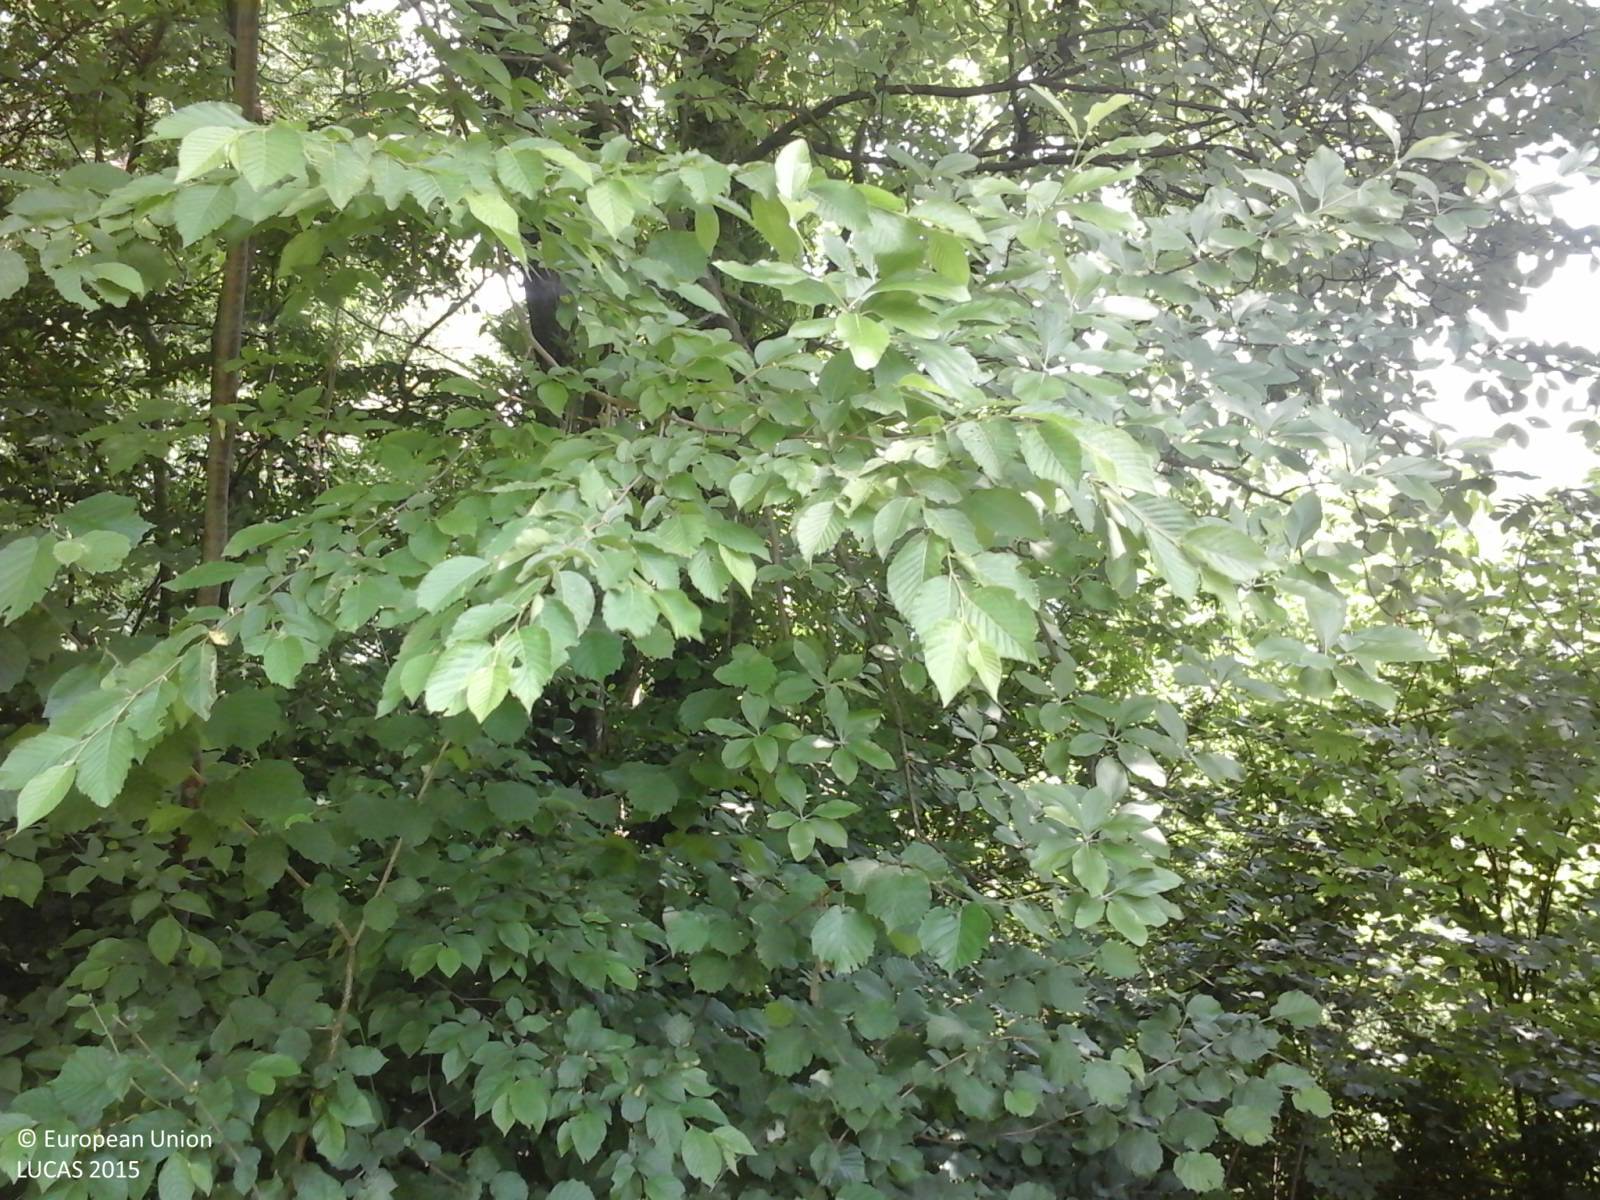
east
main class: Woodland
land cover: Broadleaved woodland
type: thermophilous deciduous forest
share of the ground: > 75 %
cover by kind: broadleaved forest trees 90 %, shrubs 10 %
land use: Forestry
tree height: > 5 m
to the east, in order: Broadleaved woodland; Rivers and streams; Broadleaved woodland
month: June
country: IT
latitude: 46.2262
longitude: 12.7326
